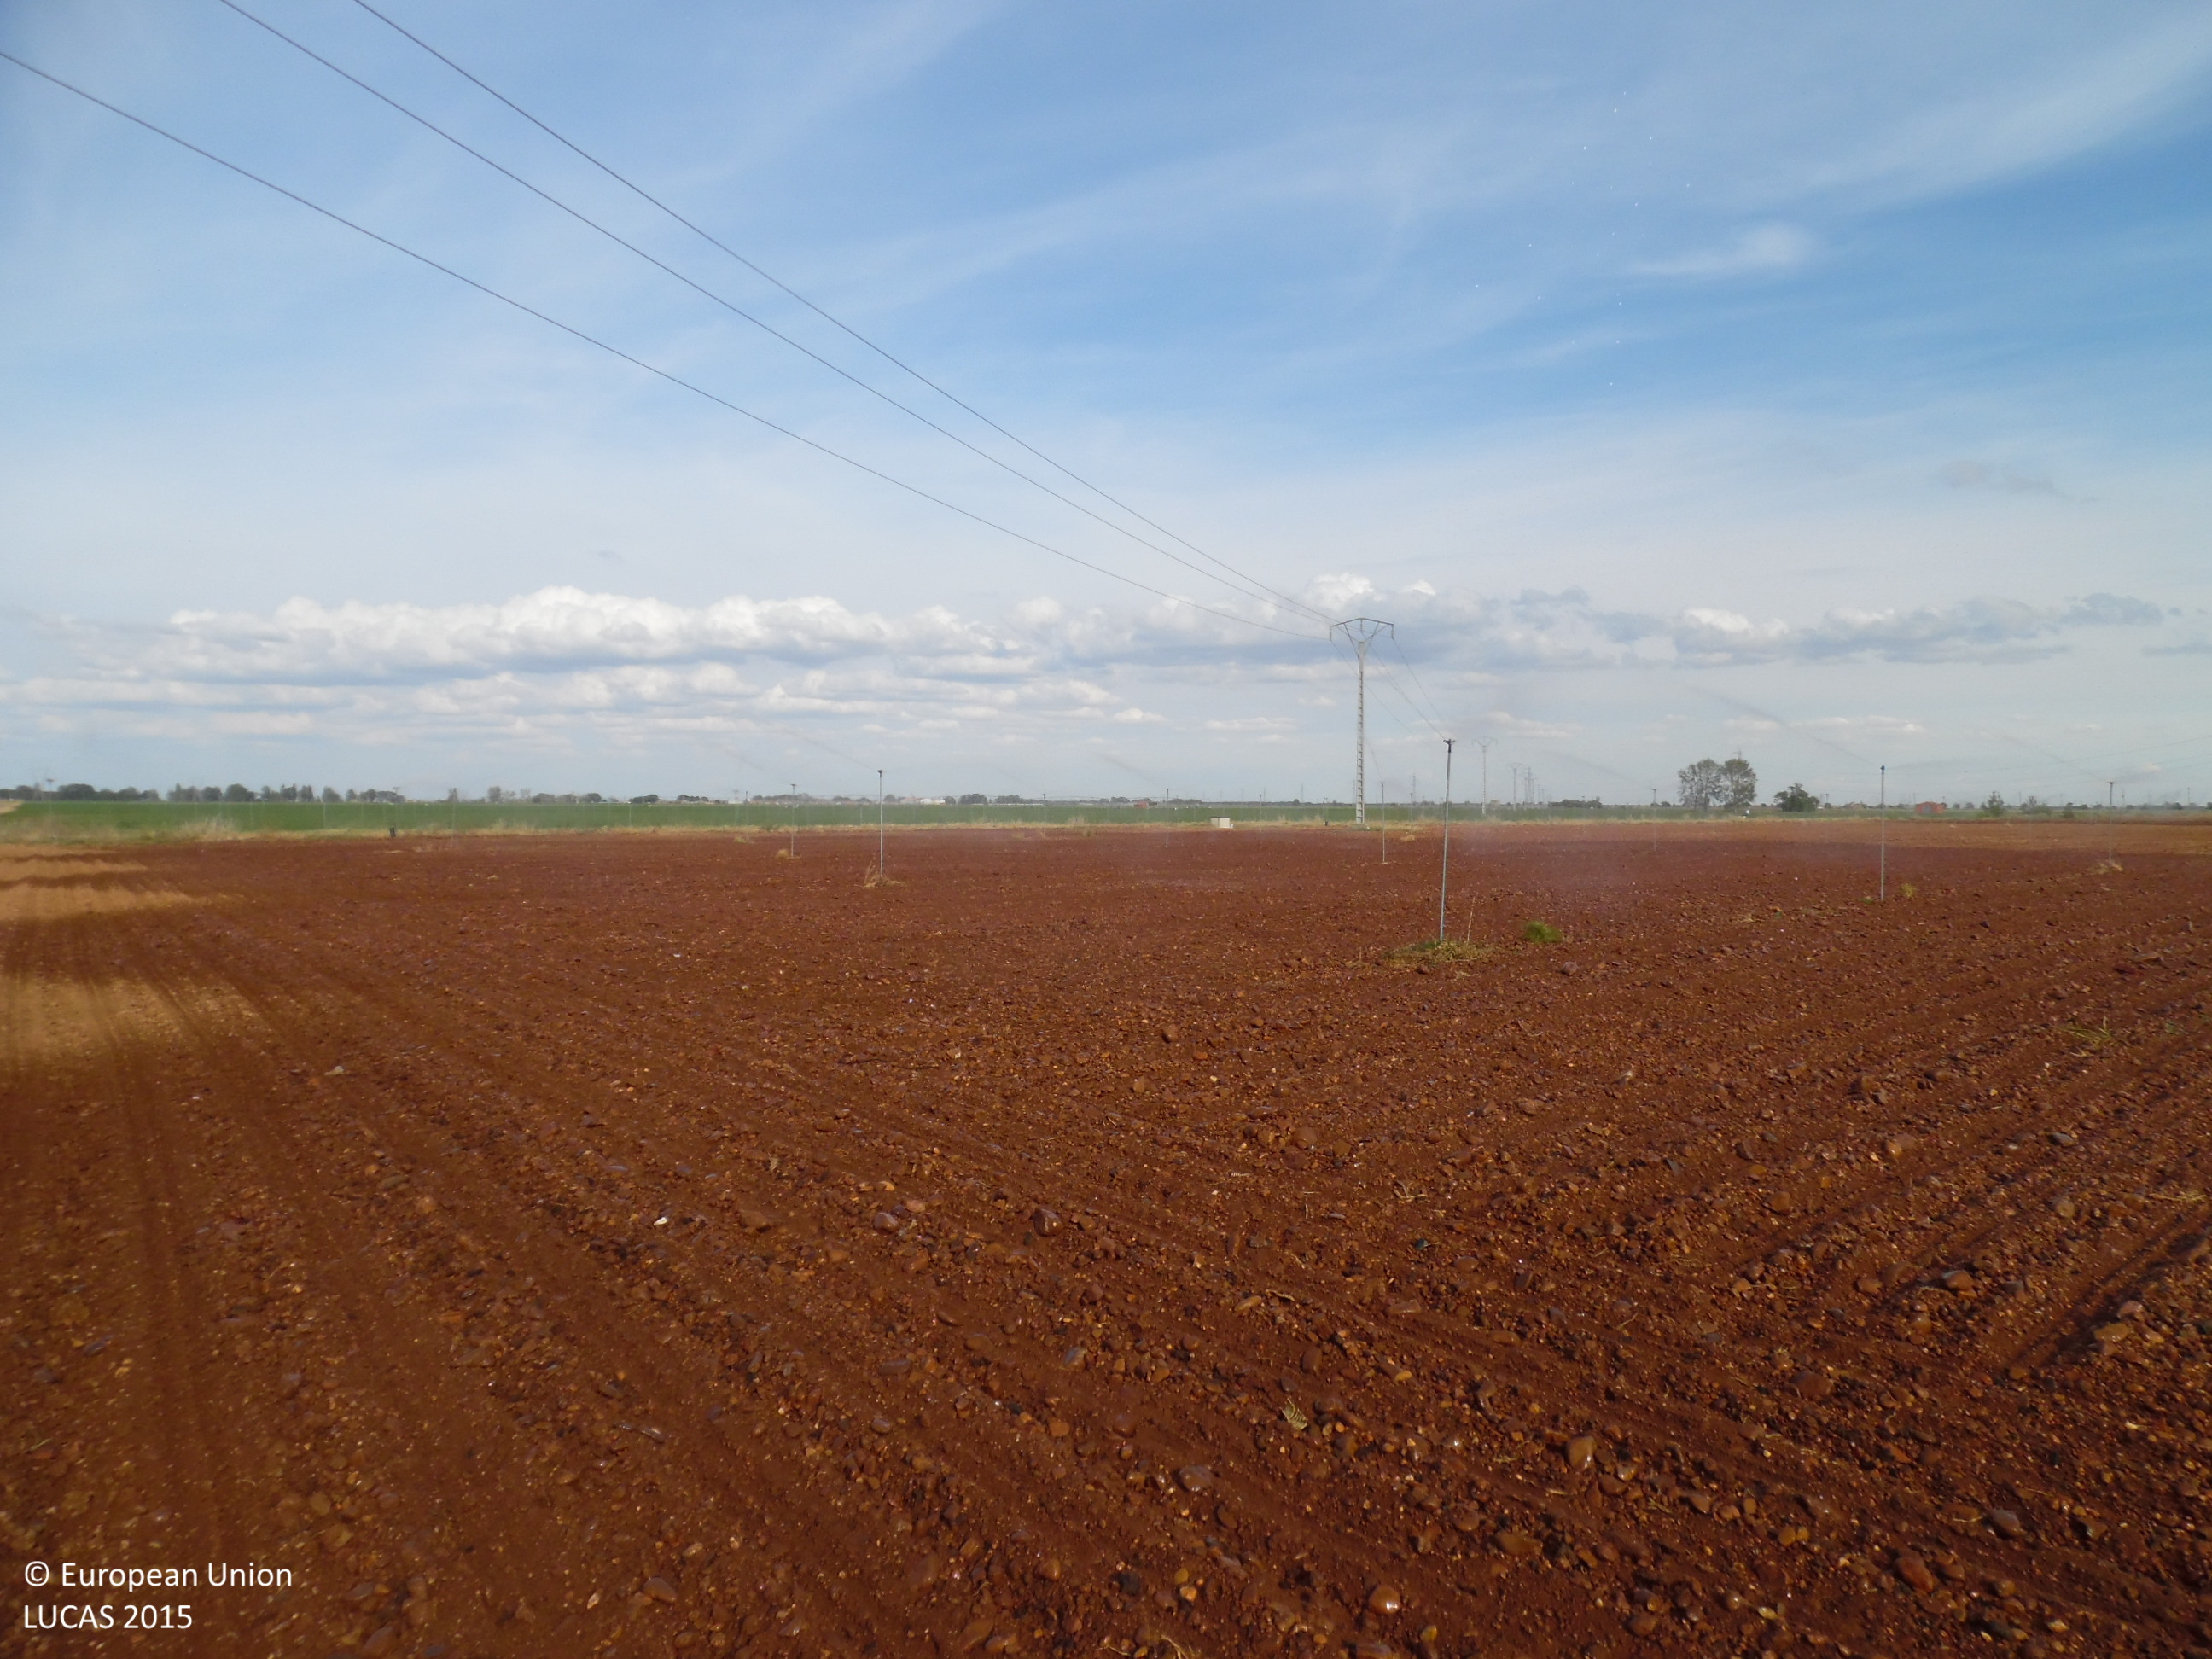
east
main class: Cropland
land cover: Maize
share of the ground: < 10 %
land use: Agriculture (excluding fallow land and kitchen gardens)
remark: Temporary flooded
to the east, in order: Maize; Electric lines; Maize; Grass margins; Tracks; Grass margins; Maize
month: June
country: ES
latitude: 42.3362
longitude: -5.7171
